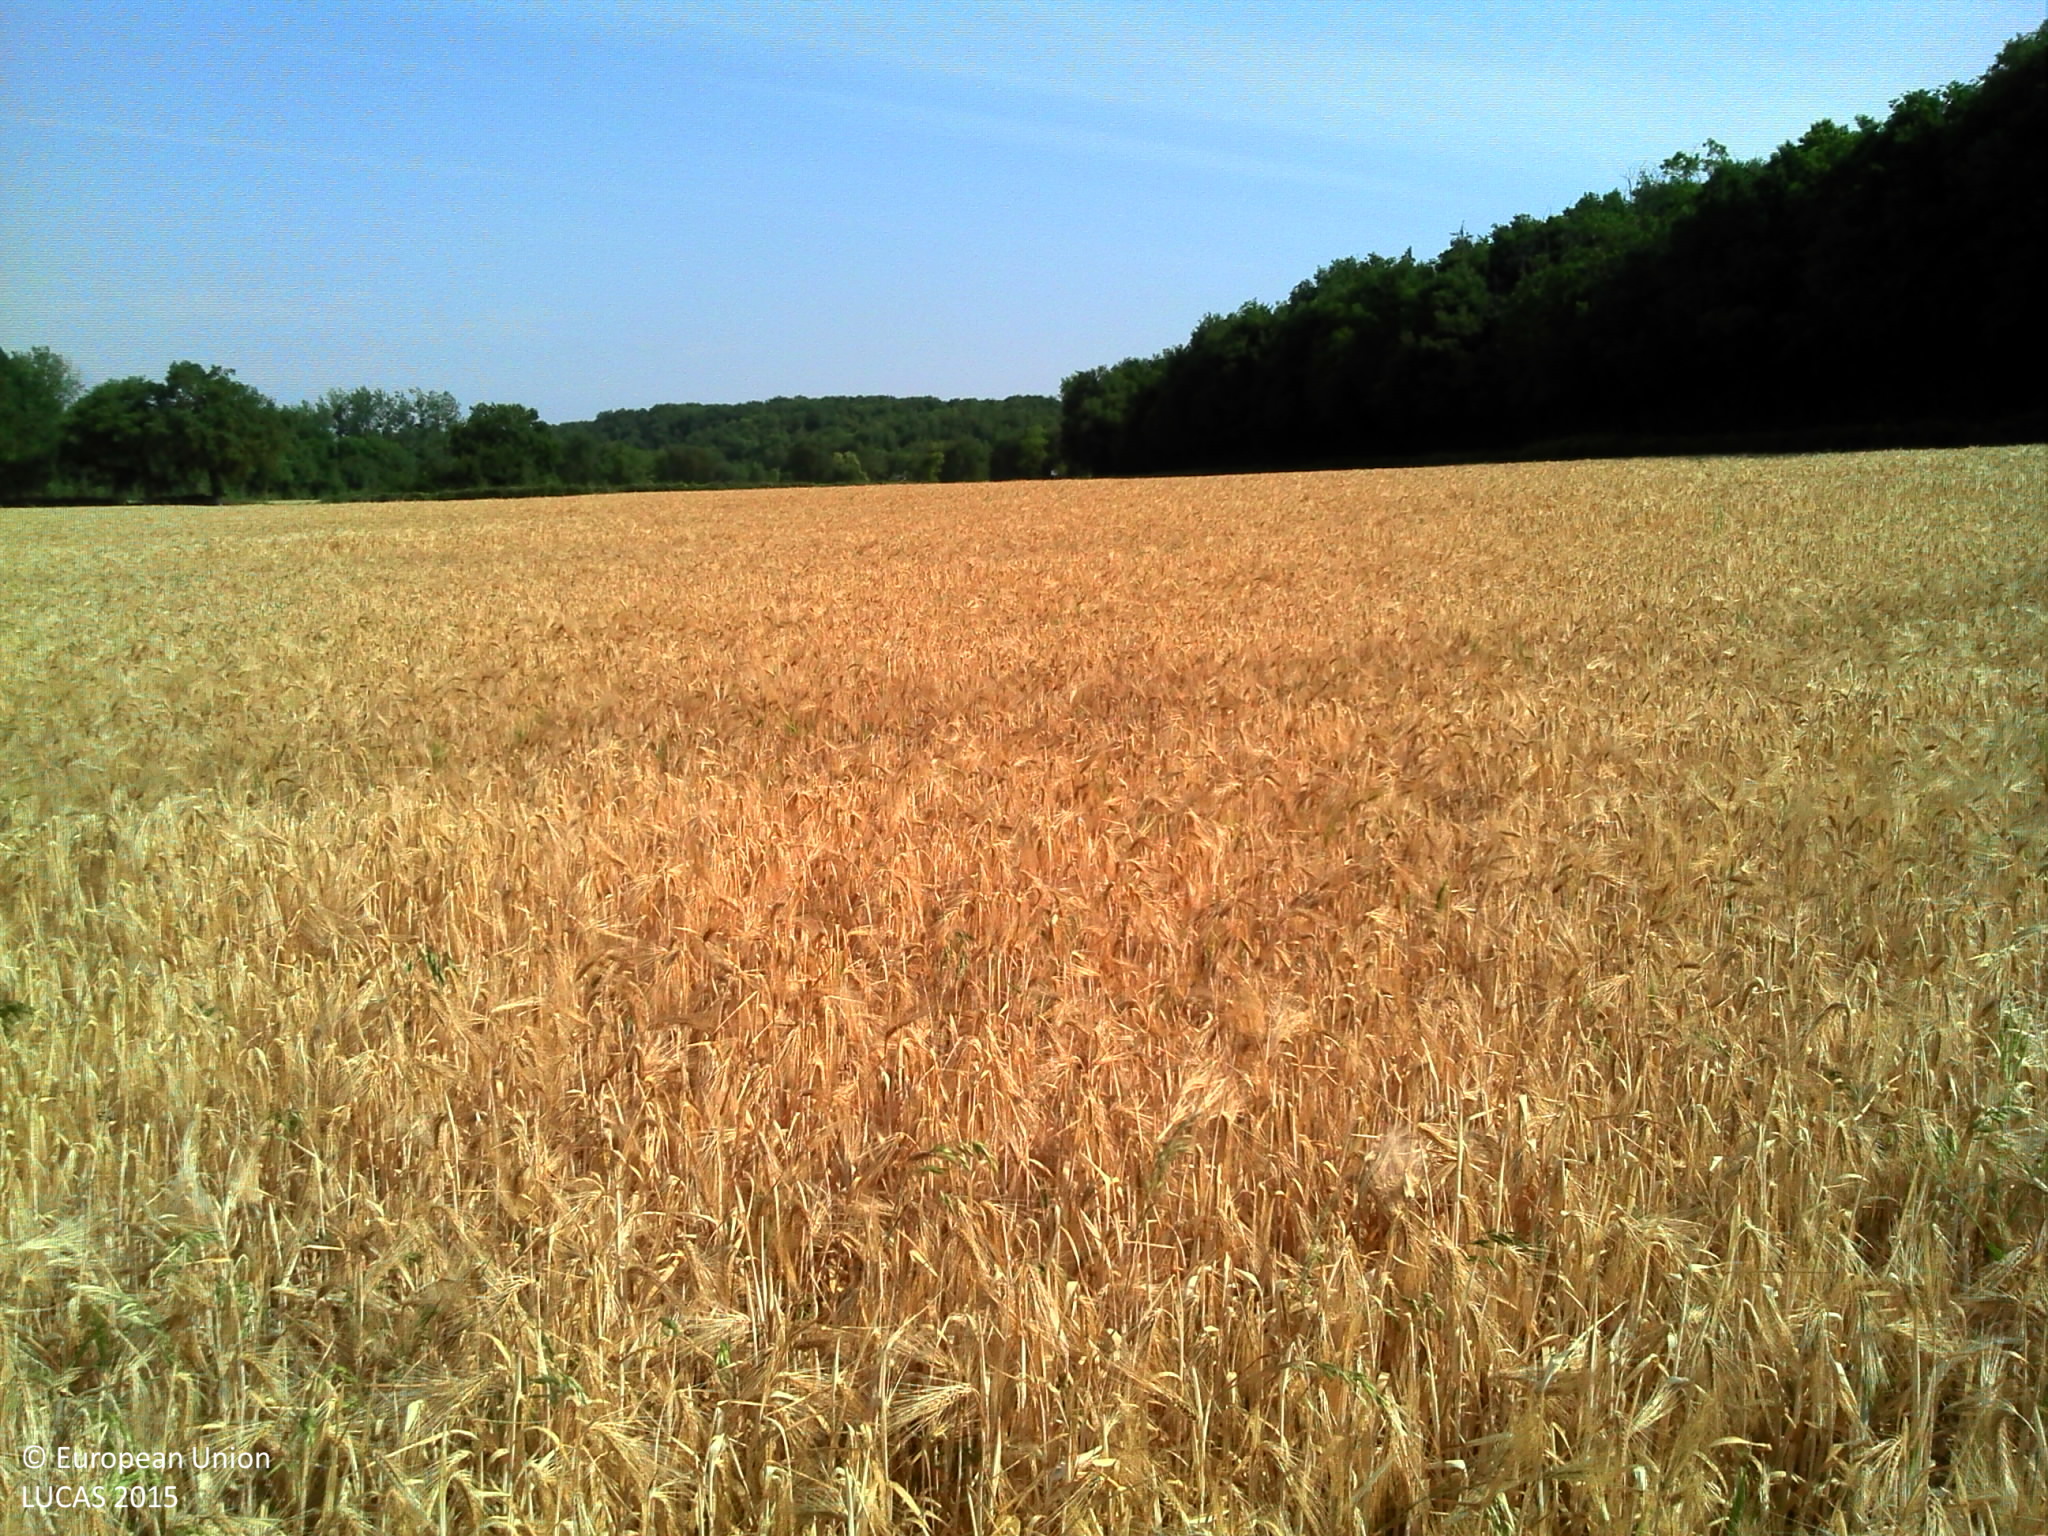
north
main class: Cropland
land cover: Barley
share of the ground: > 75 %
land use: Agriculture (excluding fallow land and kitchen gardens)
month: June
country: FR
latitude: 46.6292
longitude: 0.8550
